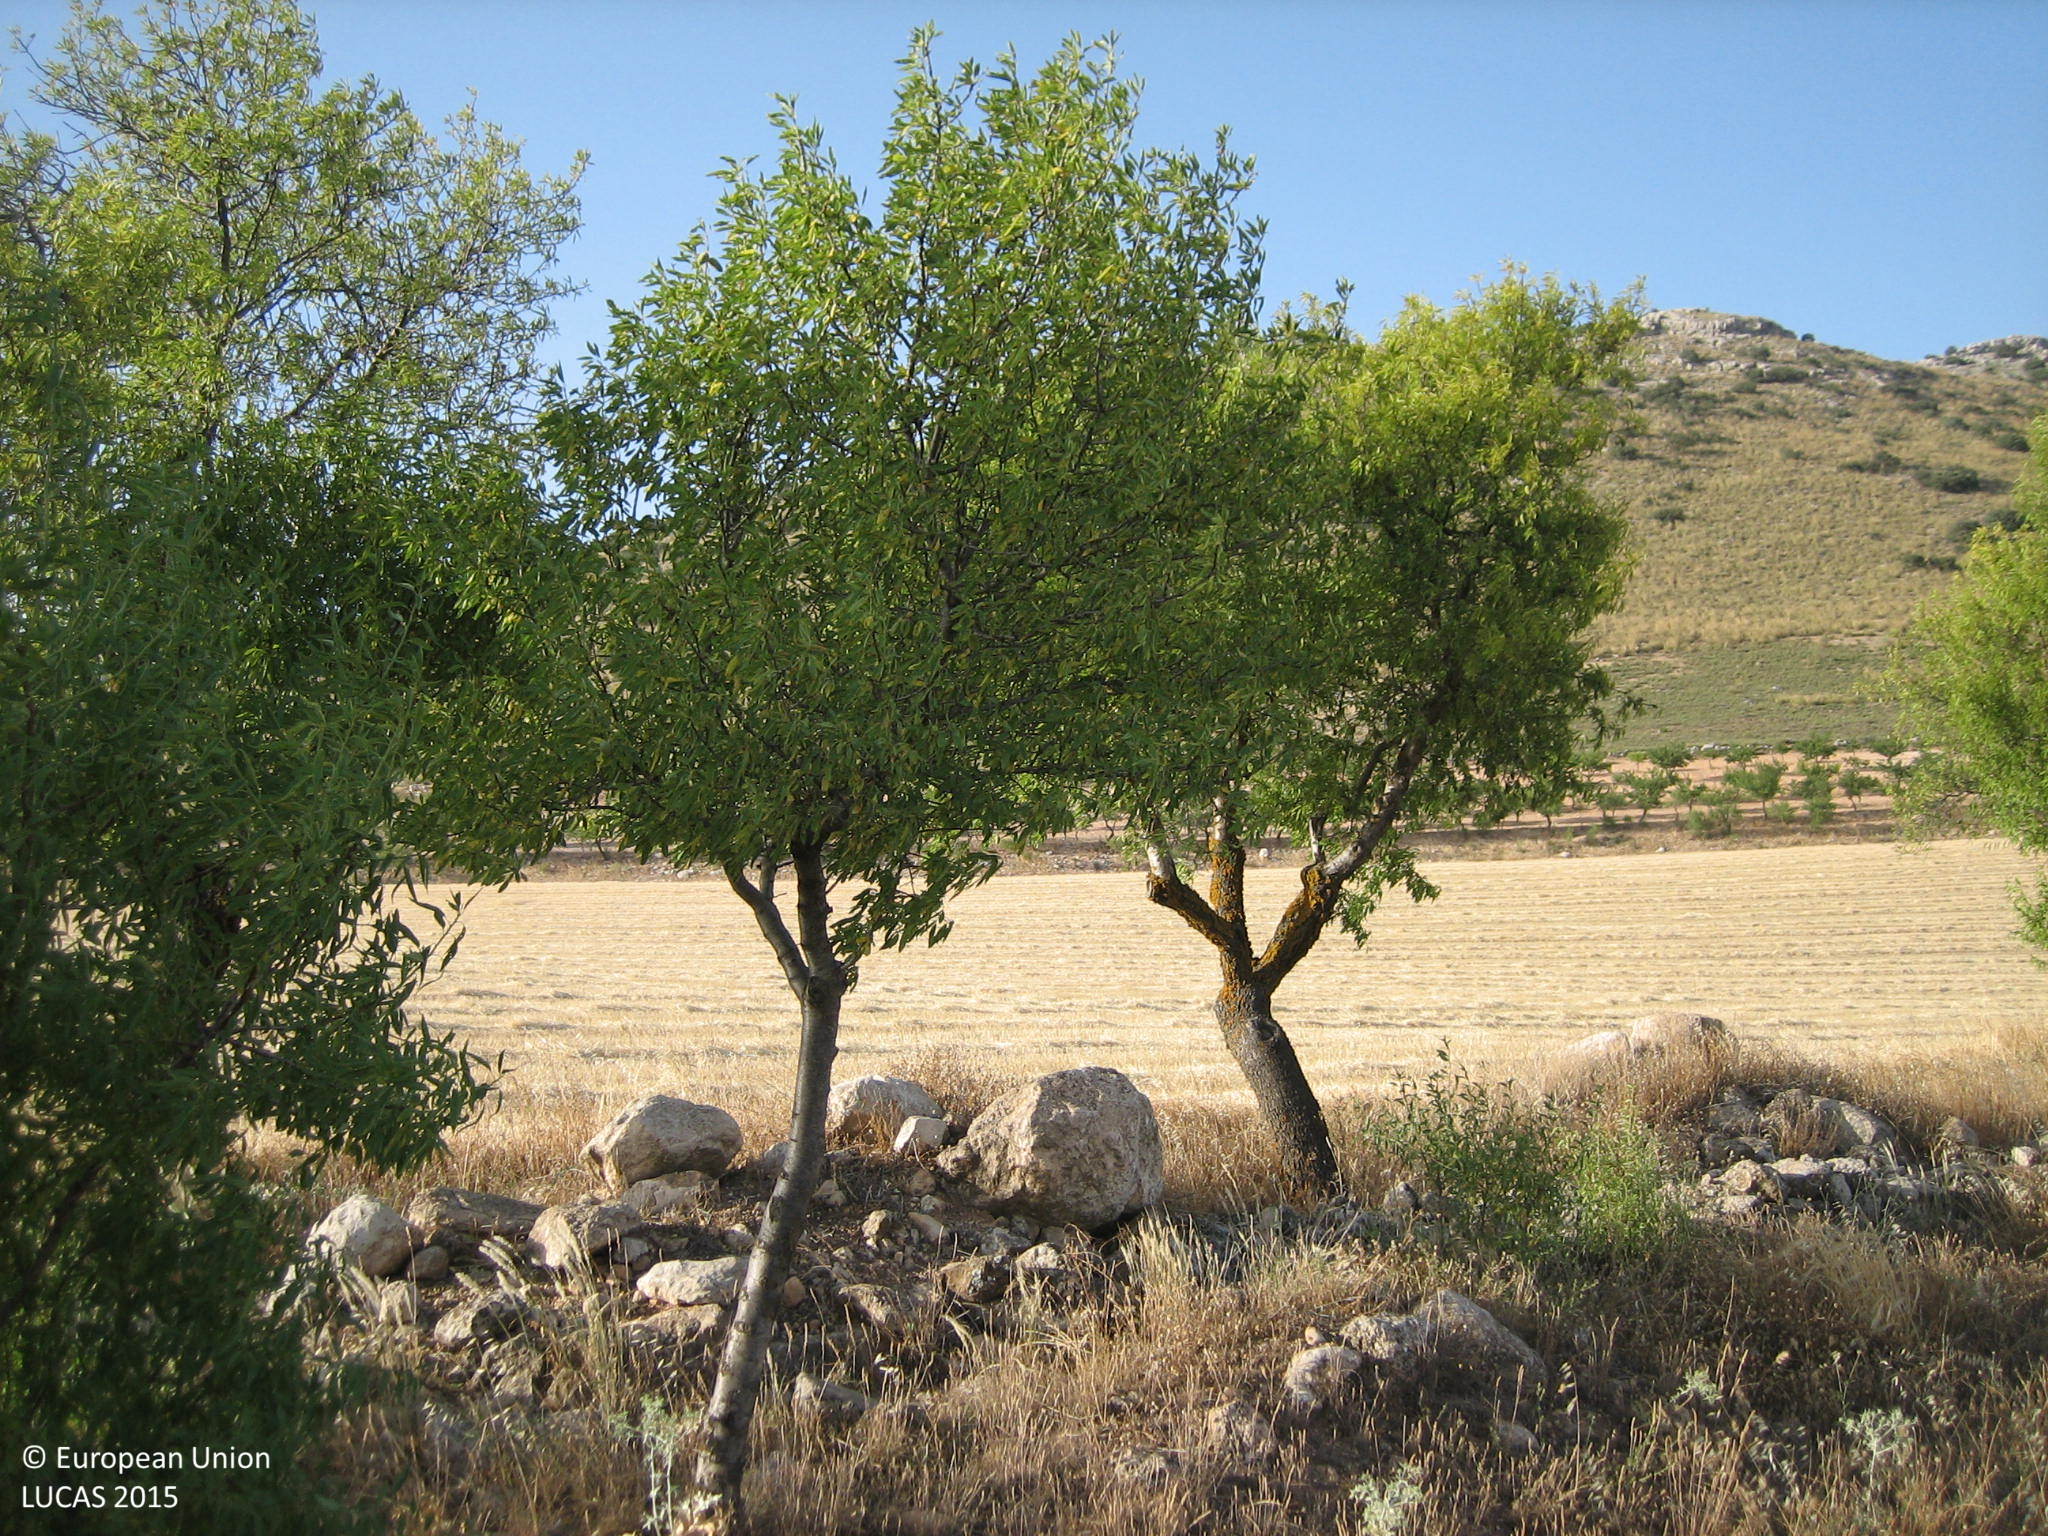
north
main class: Cropland
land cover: Barley
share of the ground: < 10 %
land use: Agriculture (excluding fallow land and kitchen gardens)
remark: Harvested field
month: July
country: ES
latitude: 37.6118
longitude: -2.3907
